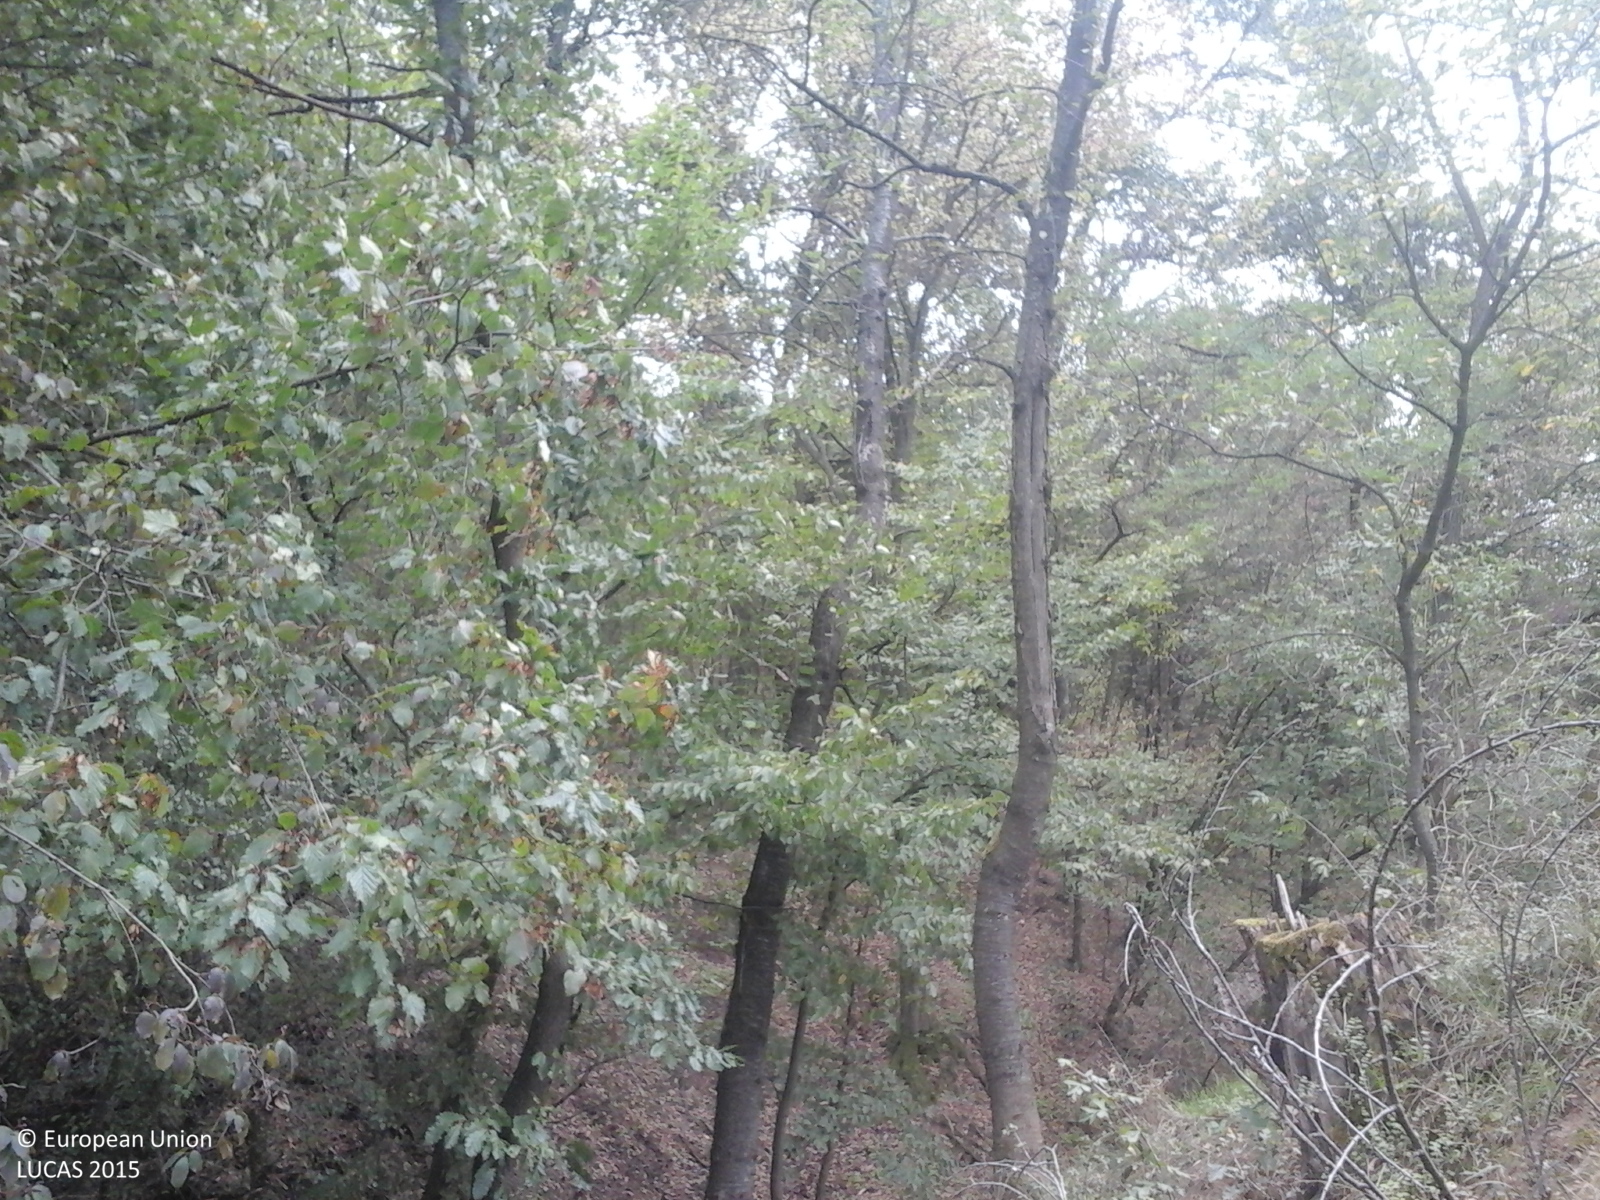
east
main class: Woodland
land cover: Broadleaved woodland
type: exotic forest
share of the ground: > 75 %
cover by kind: broadleaved forest trees 100 %
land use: Forestry
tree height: > 5 m
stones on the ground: < 10 %
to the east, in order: Broadleaved woodland; Shrubland with sparse tree cover; Grassland with sparse tree/shrub cover; Shrubland with sparse tree cover; Grassland with sparse tree/shrub cover
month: September
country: RO
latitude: 45.8752
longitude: 23.0557
